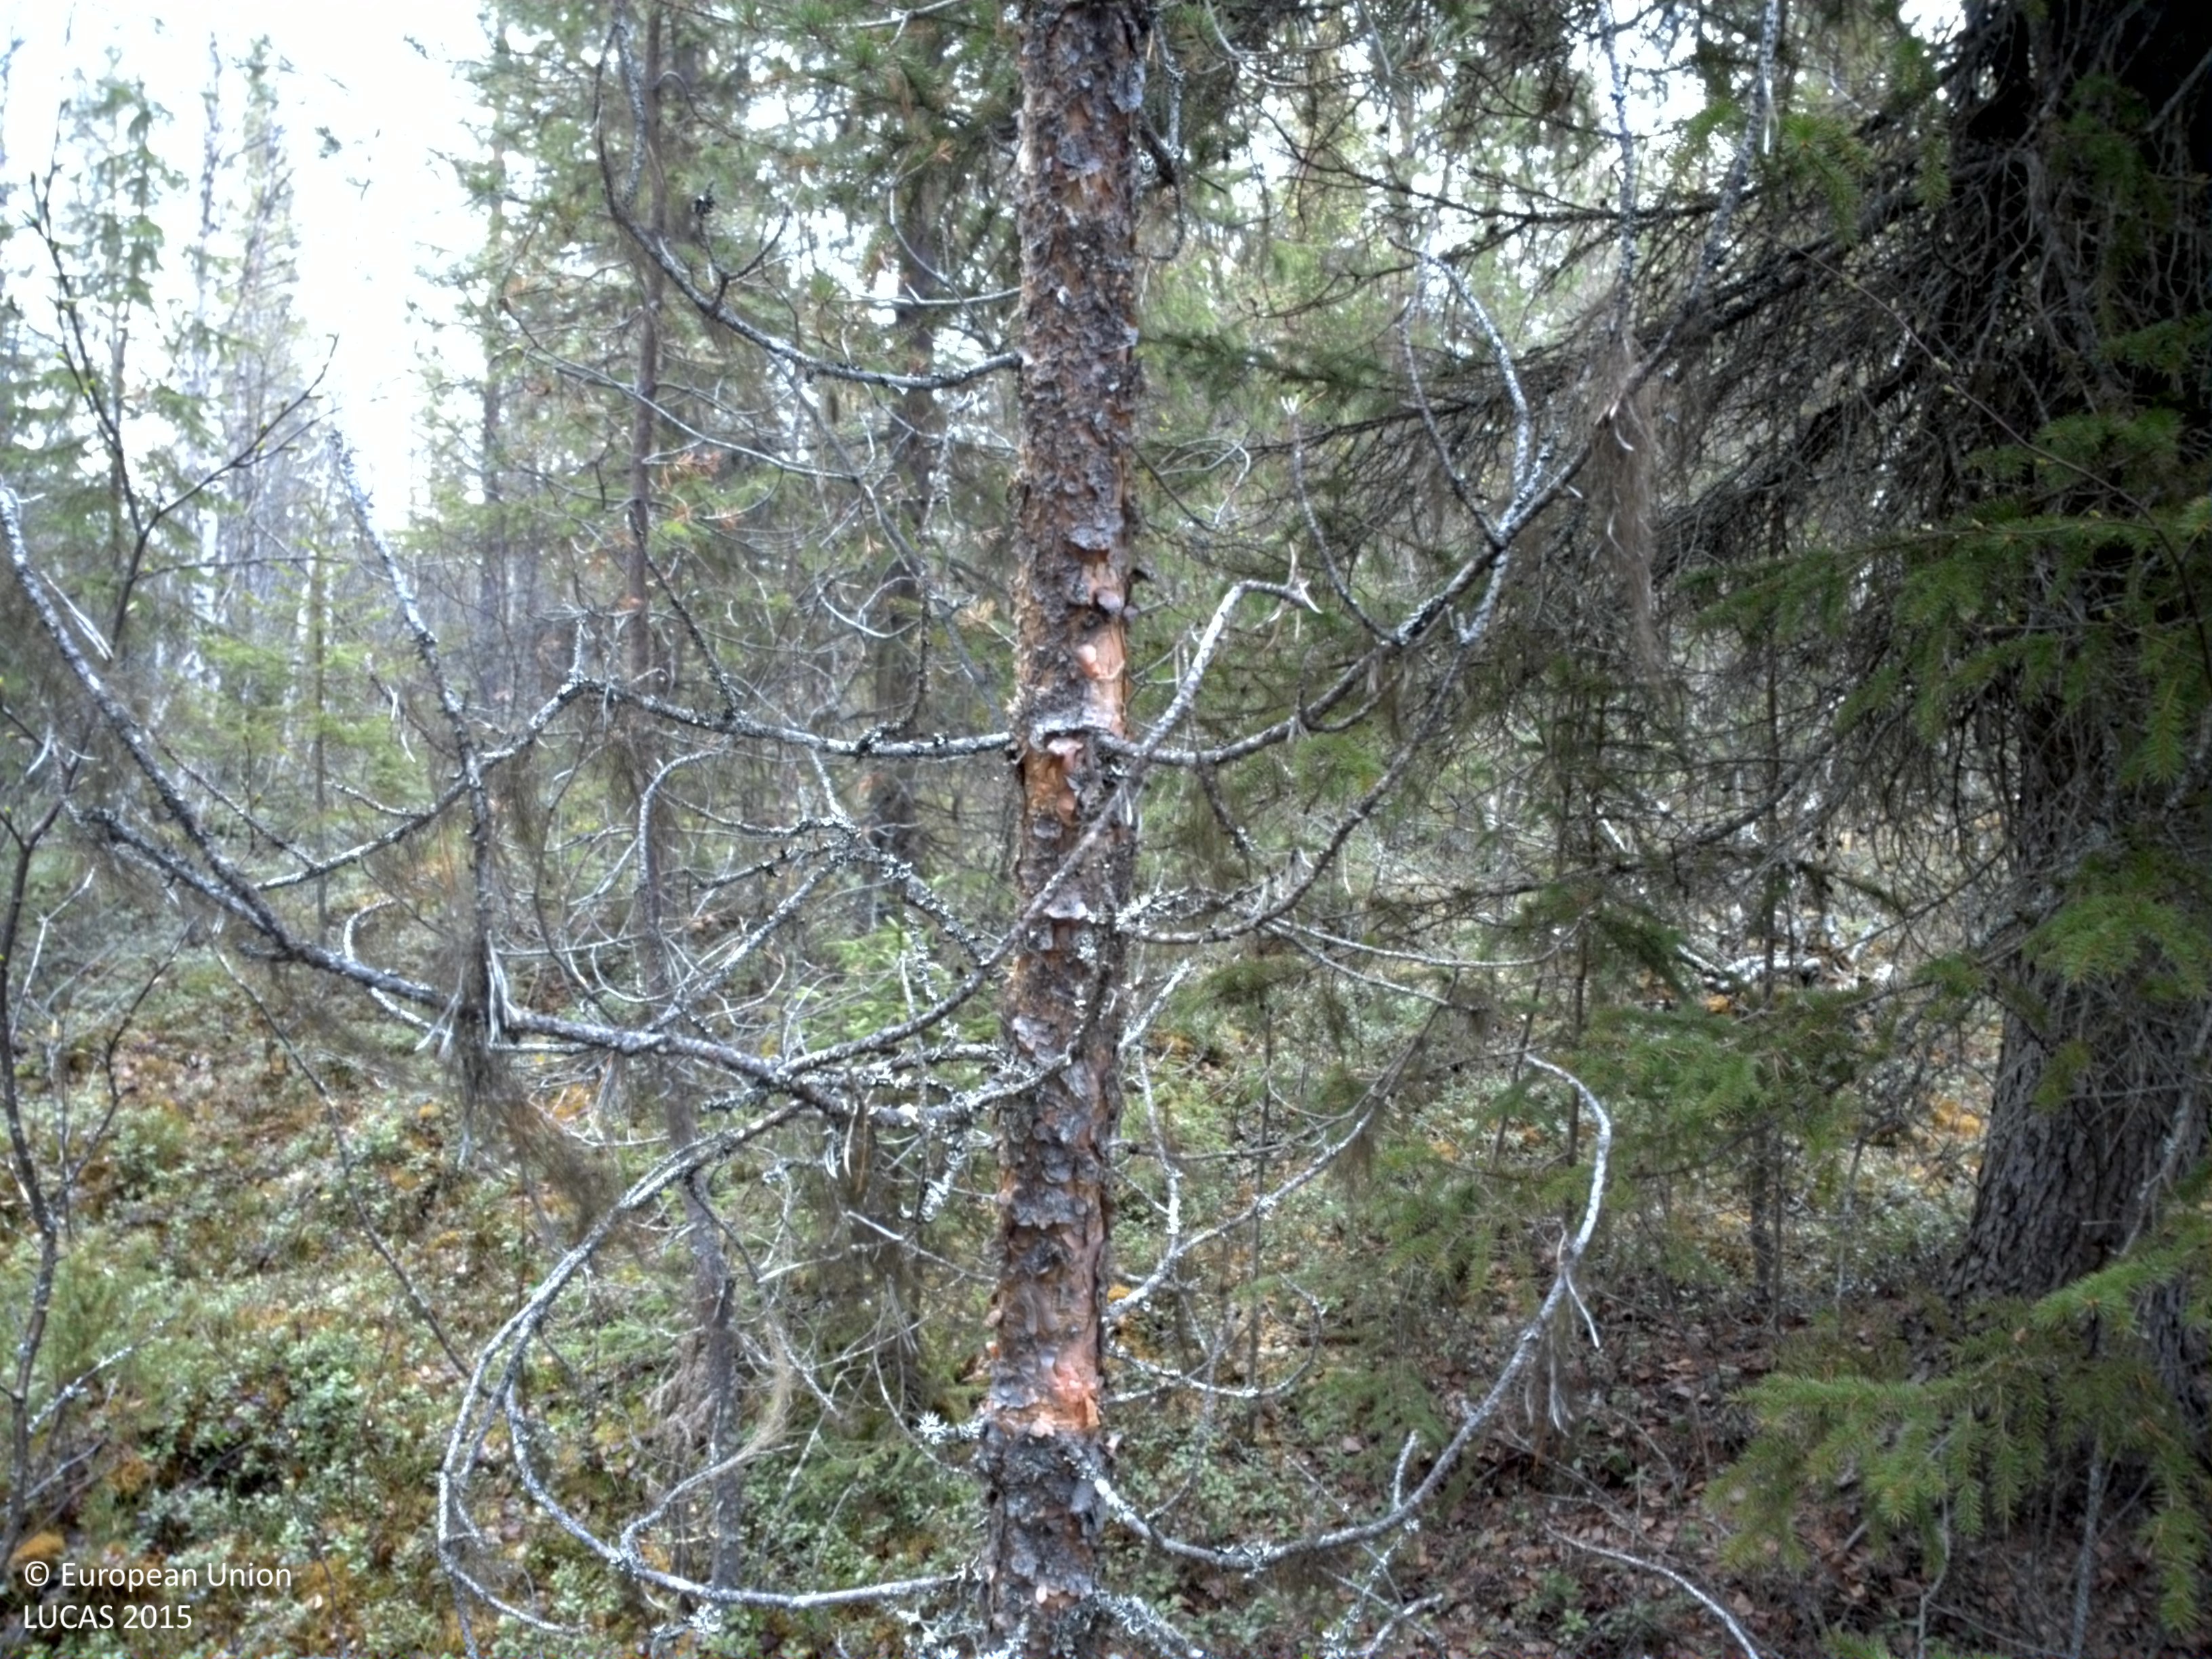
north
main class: Woodland
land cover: Spruce dominated mixed woodland
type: boreal forest
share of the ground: > 75 %
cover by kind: coniferous forest trees 55 %, broadleaved forest trees 25 %, shrubs 20 %
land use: Forestry
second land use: Amenities, museums, leisure
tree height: > 5 m
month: June
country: SE
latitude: 63.6431
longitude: 14.6404
